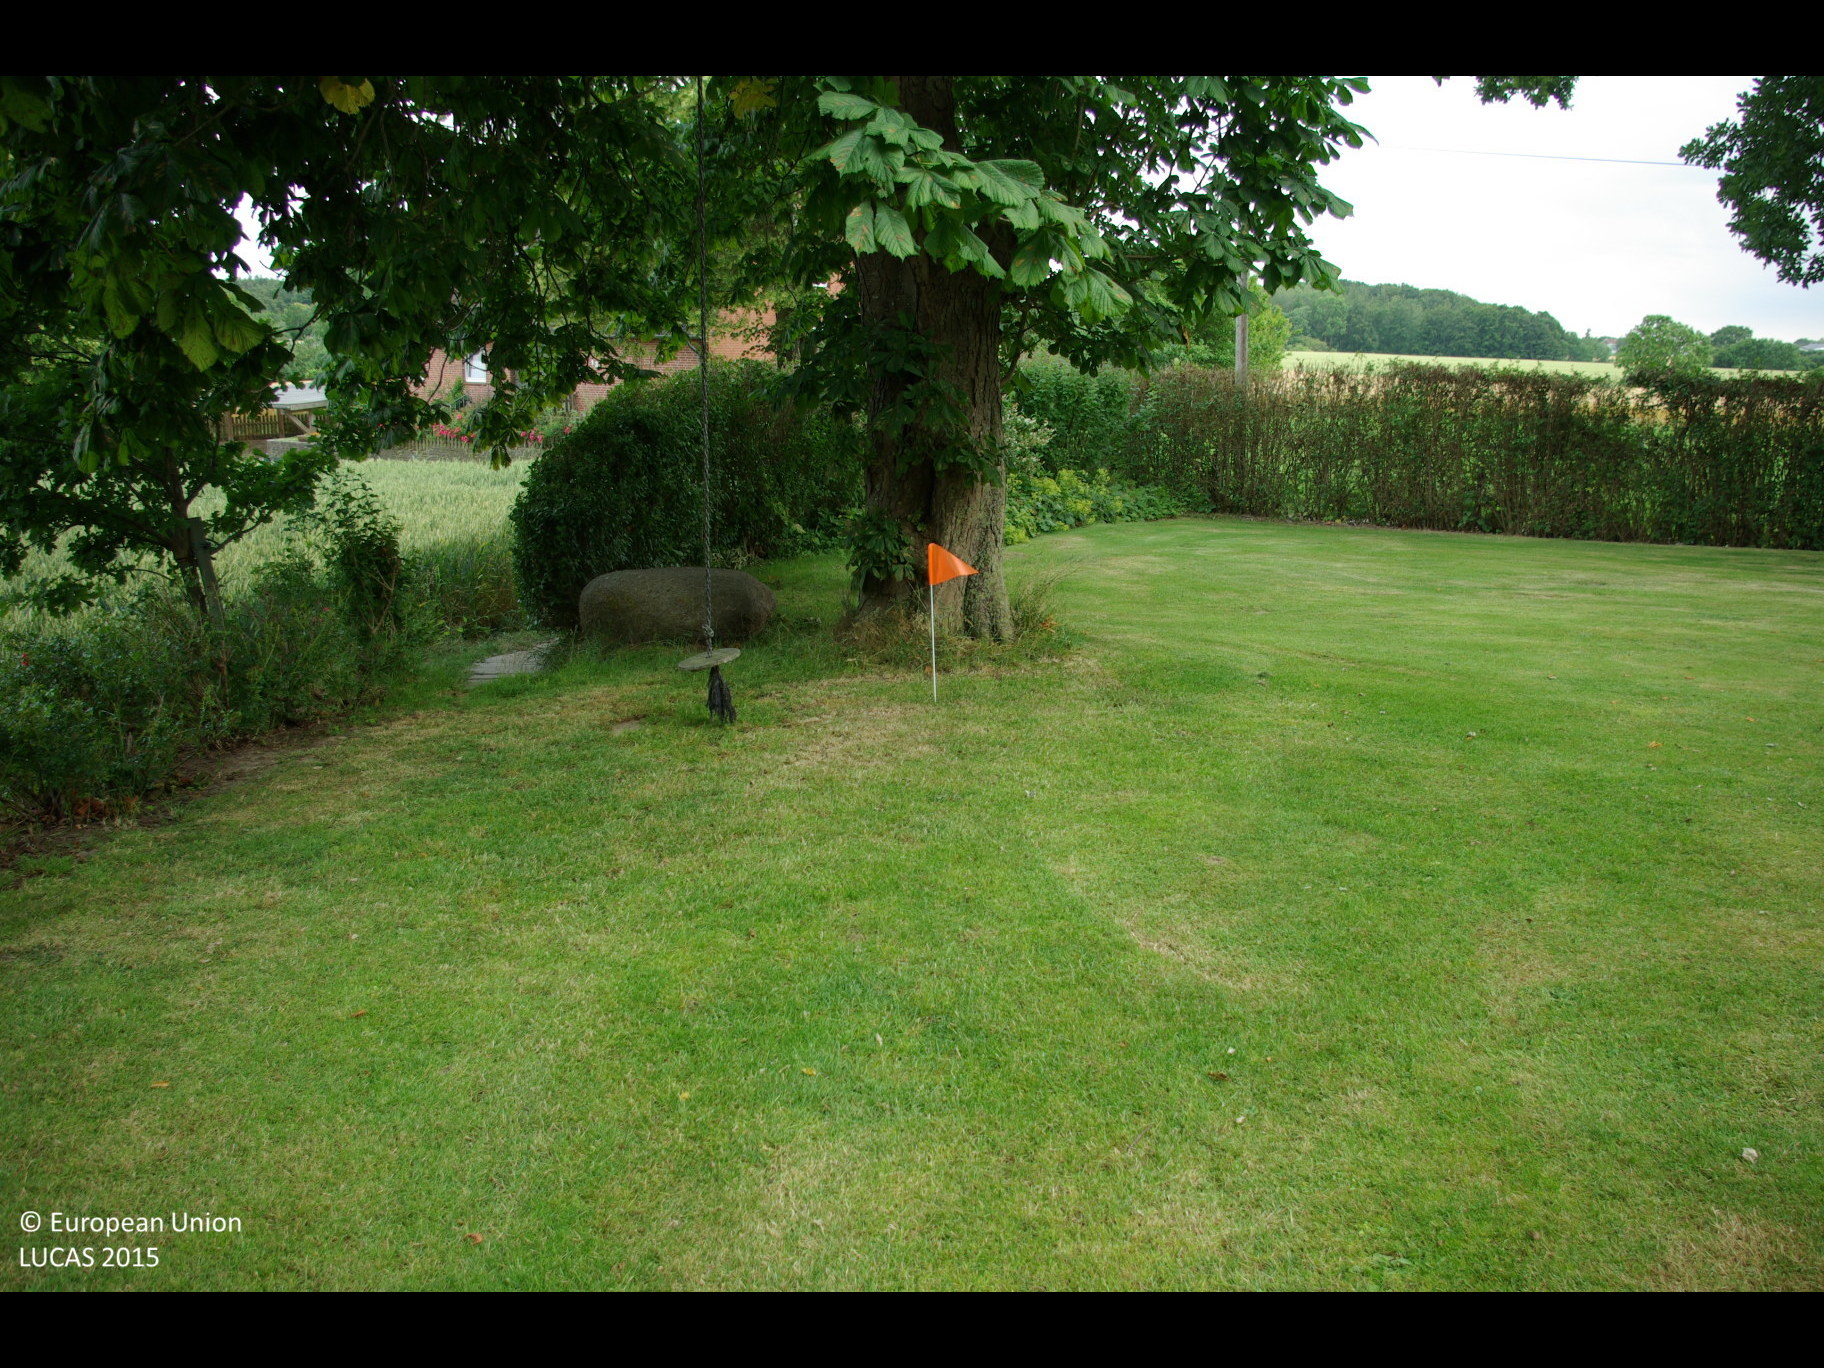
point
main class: Woodland
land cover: Broadleaved woodland
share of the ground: 50 - 75 %
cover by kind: broadleaved forest trees 50 %, herbaceous plants 50 %
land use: Residential
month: July
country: DE
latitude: 54.6779
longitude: 9.9225
